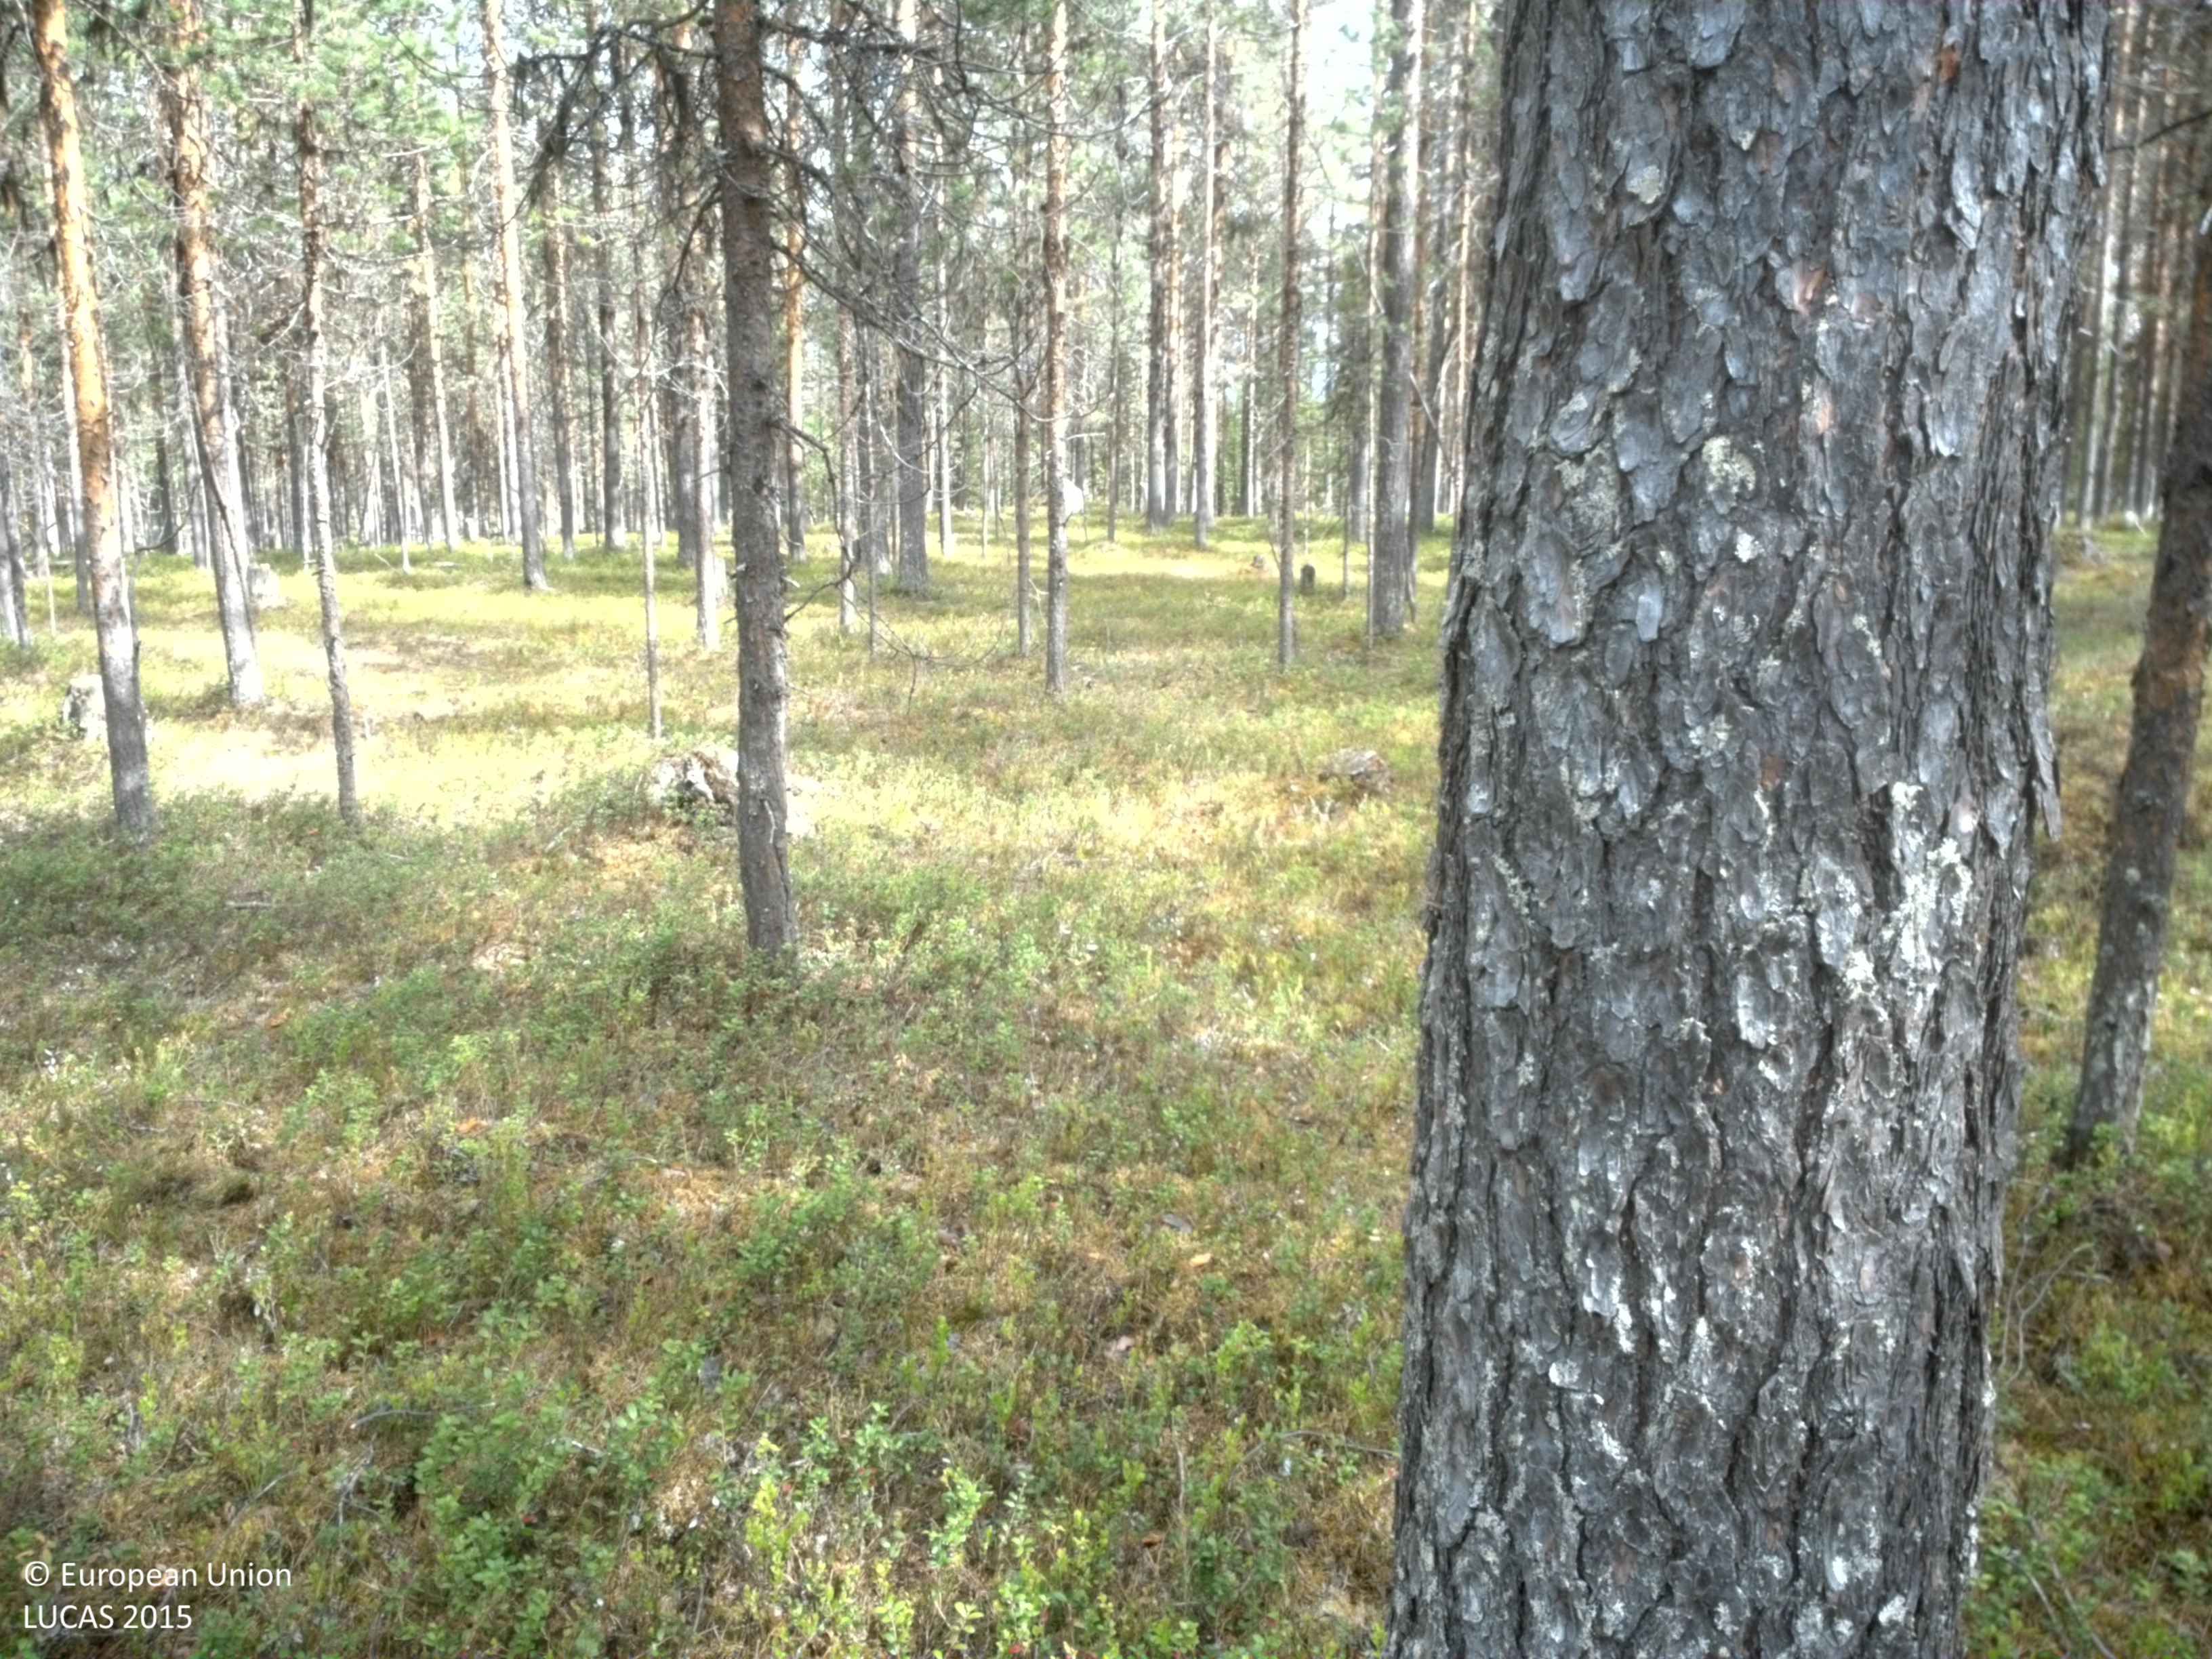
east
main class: Woodland
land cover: Pine dominated coniferous woodland
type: boreal forest
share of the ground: 25 - 50 %
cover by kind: shrubs 65 %, coniferous forest trees 25 %, lichens and mosses 10 %
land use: Forestry
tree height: > 5 m
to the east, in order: Pine dominated coniferous woodland; Pine dominated mixed woodland
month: June
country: SE
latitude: 66.8967
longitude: 21.9510
